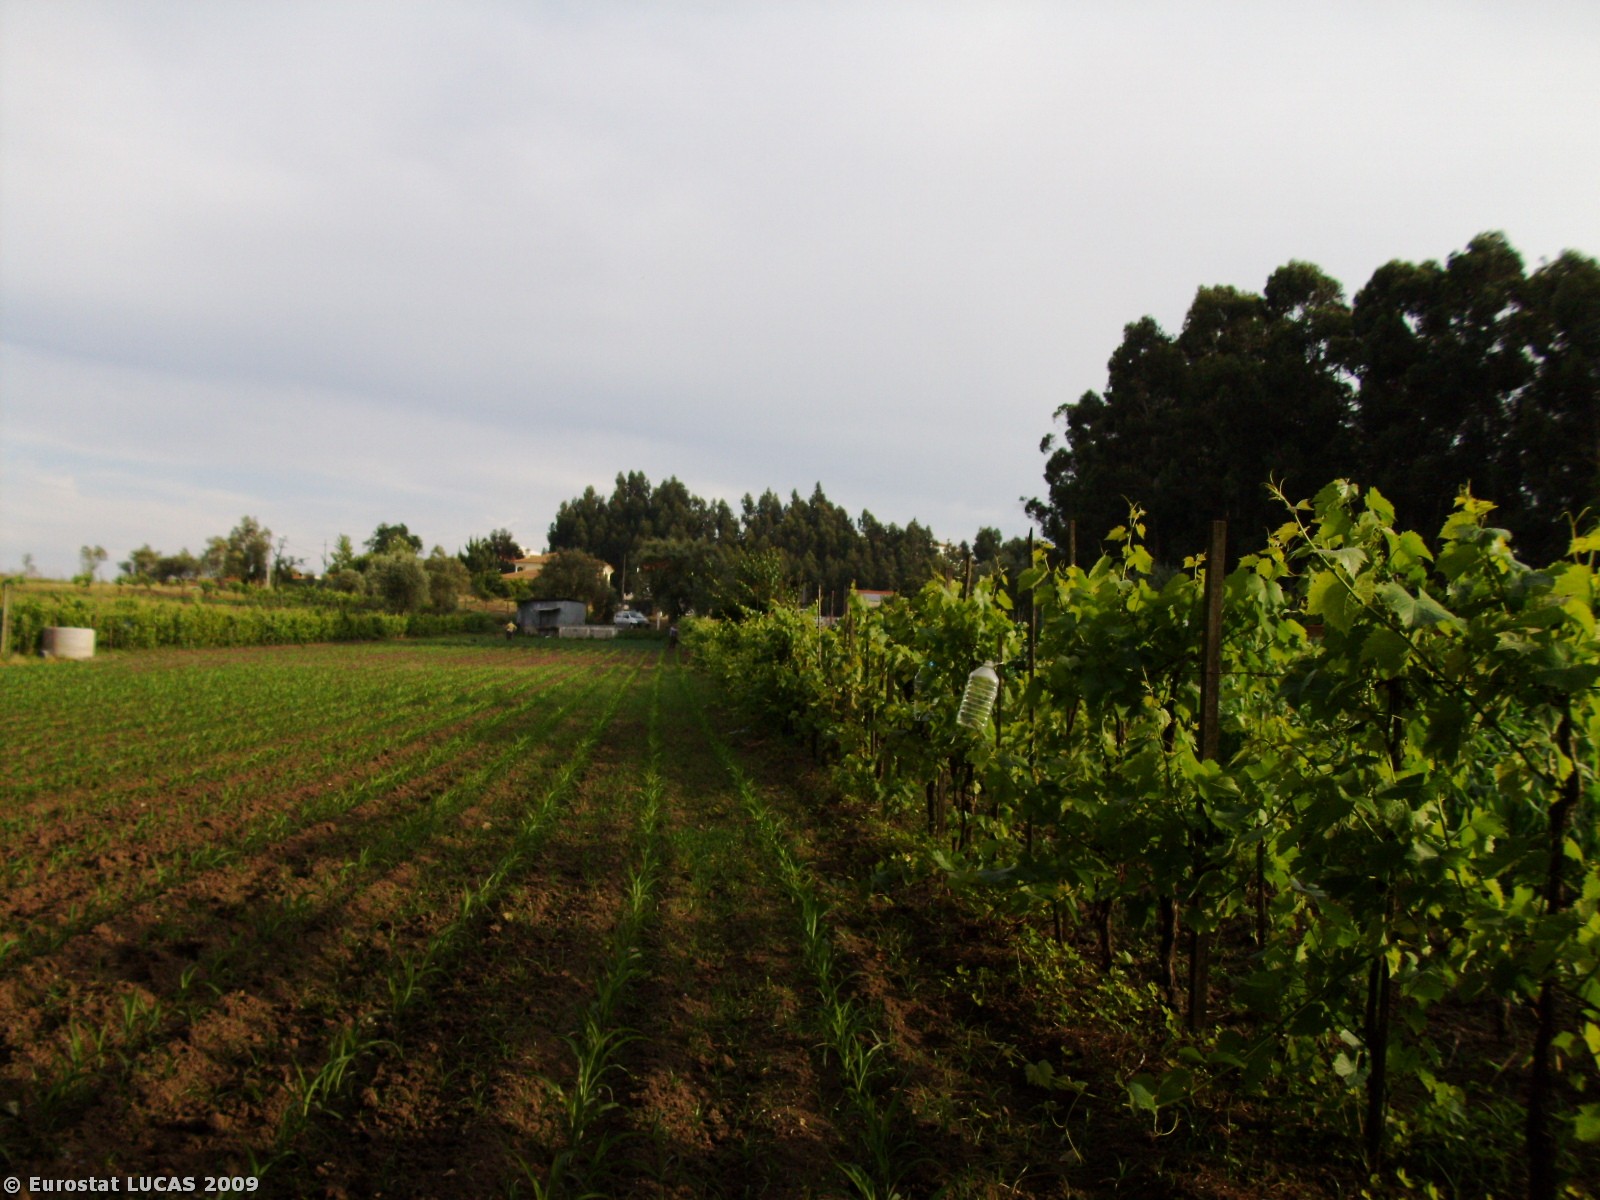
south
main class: Cropland
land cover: Maize
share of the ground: 50 - 75 %
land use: Agriculture (excluding fallow land and kitchen gardens)
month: May
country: PT
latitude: 40.5746
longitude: -8.5328
